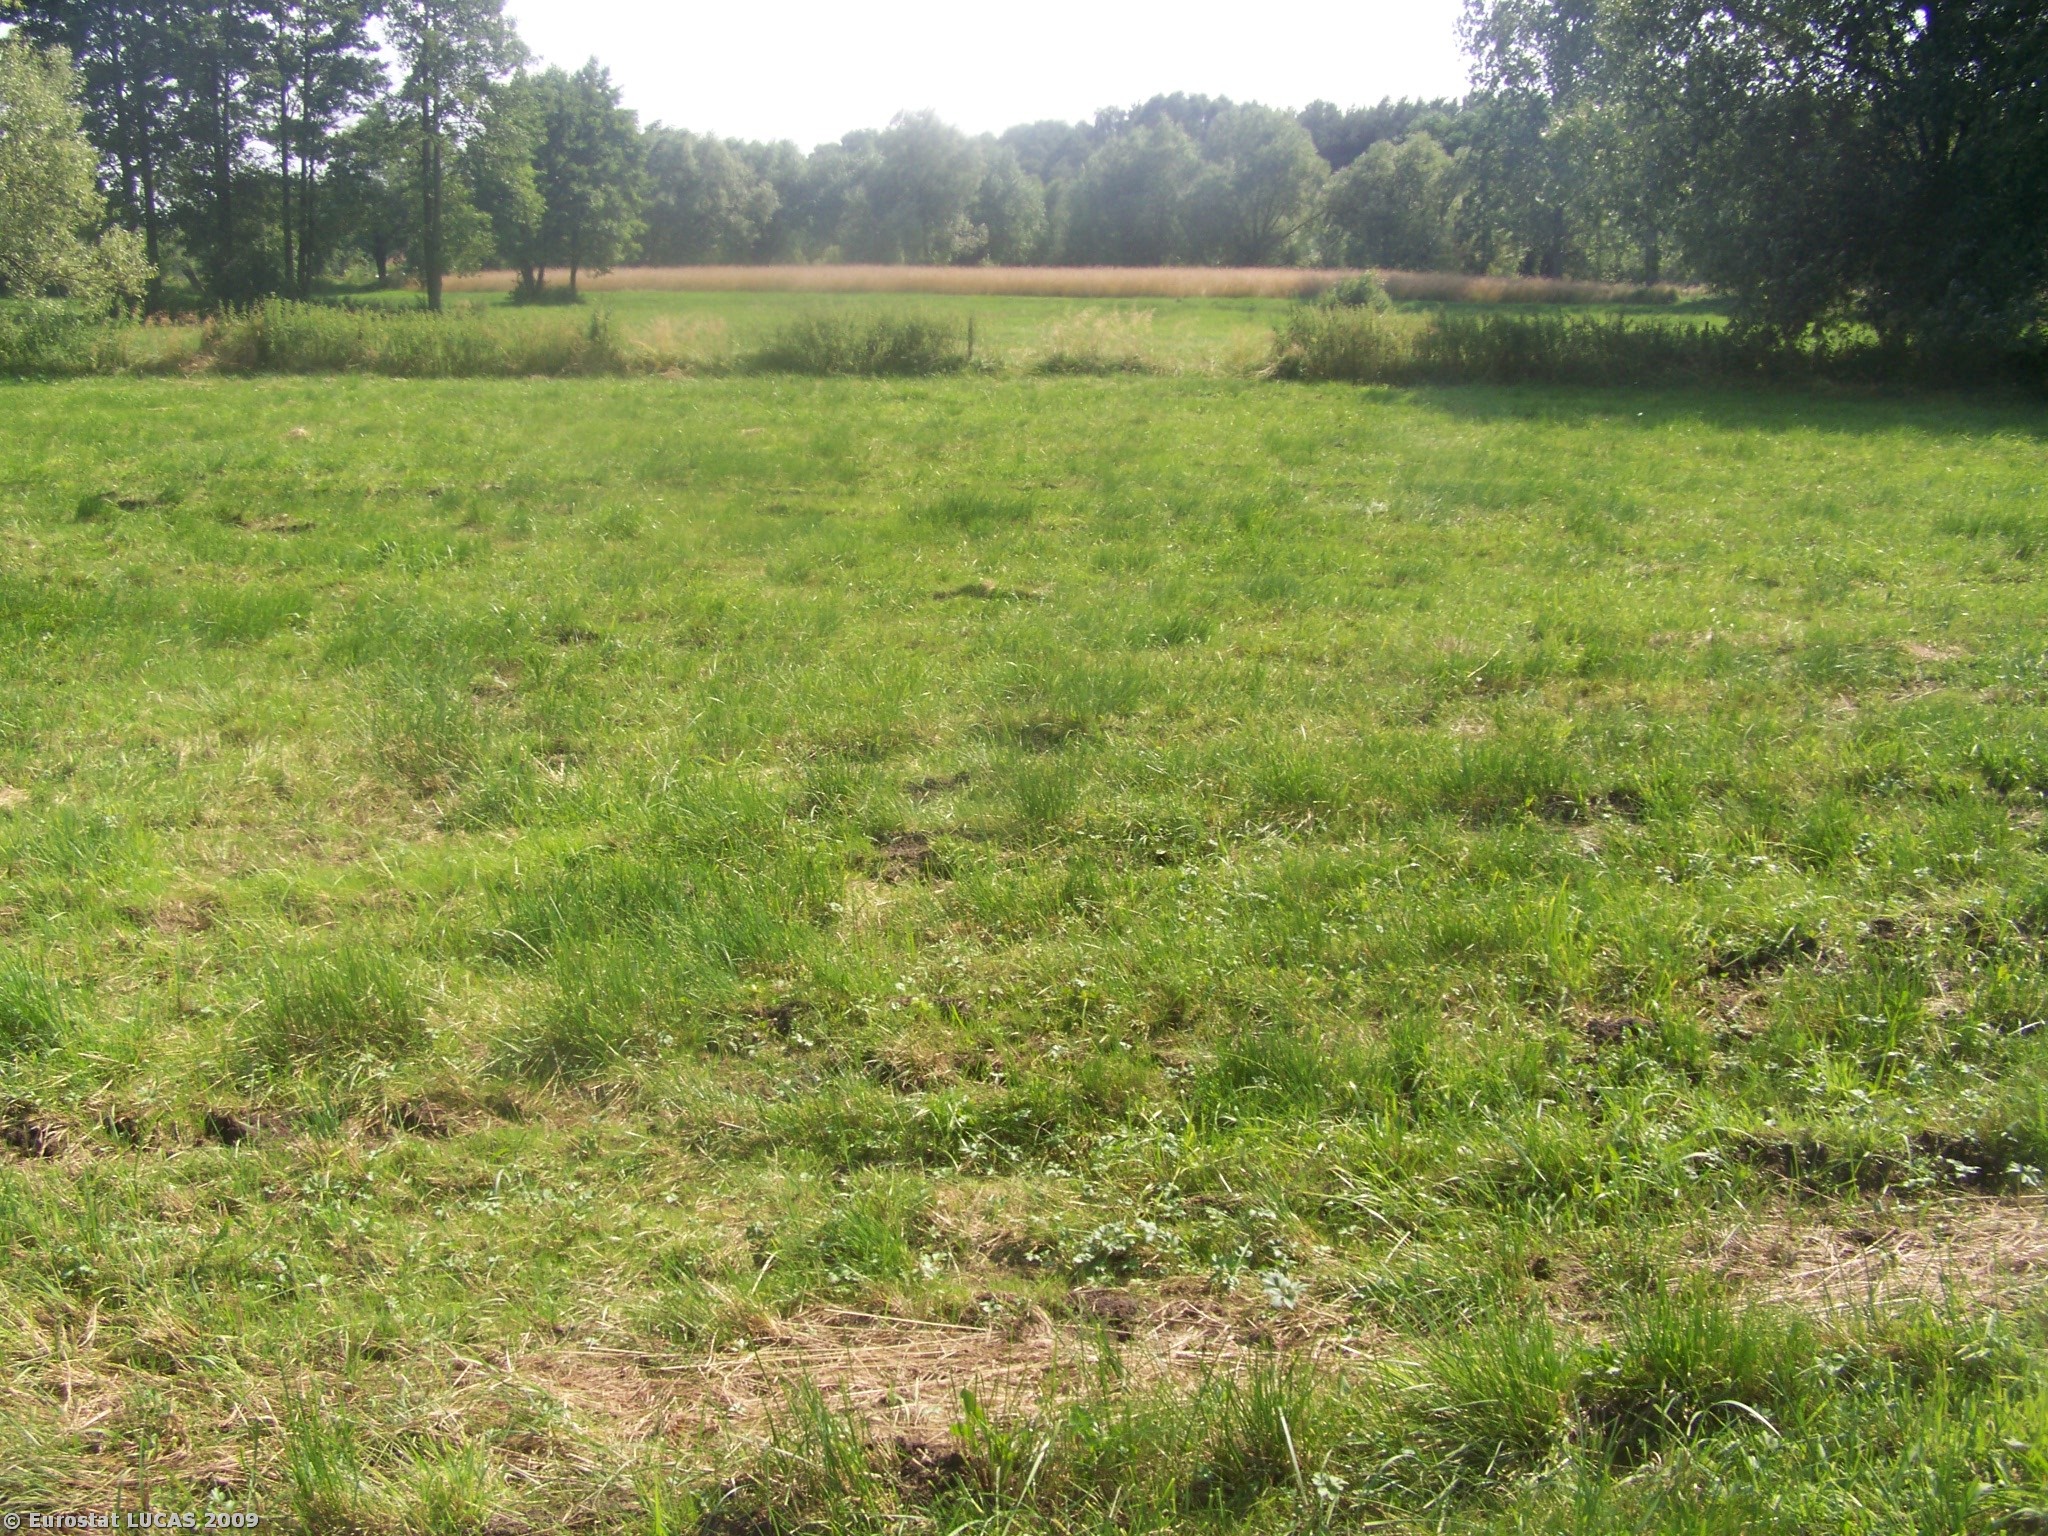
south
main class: Grassland
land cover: Grassland without tree/shrub cover
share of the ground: > 75 %
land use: Agriculture (excluding fallow land and kitchen gardens)
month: July
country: PL
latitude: 51.9648
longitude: 21.6532
